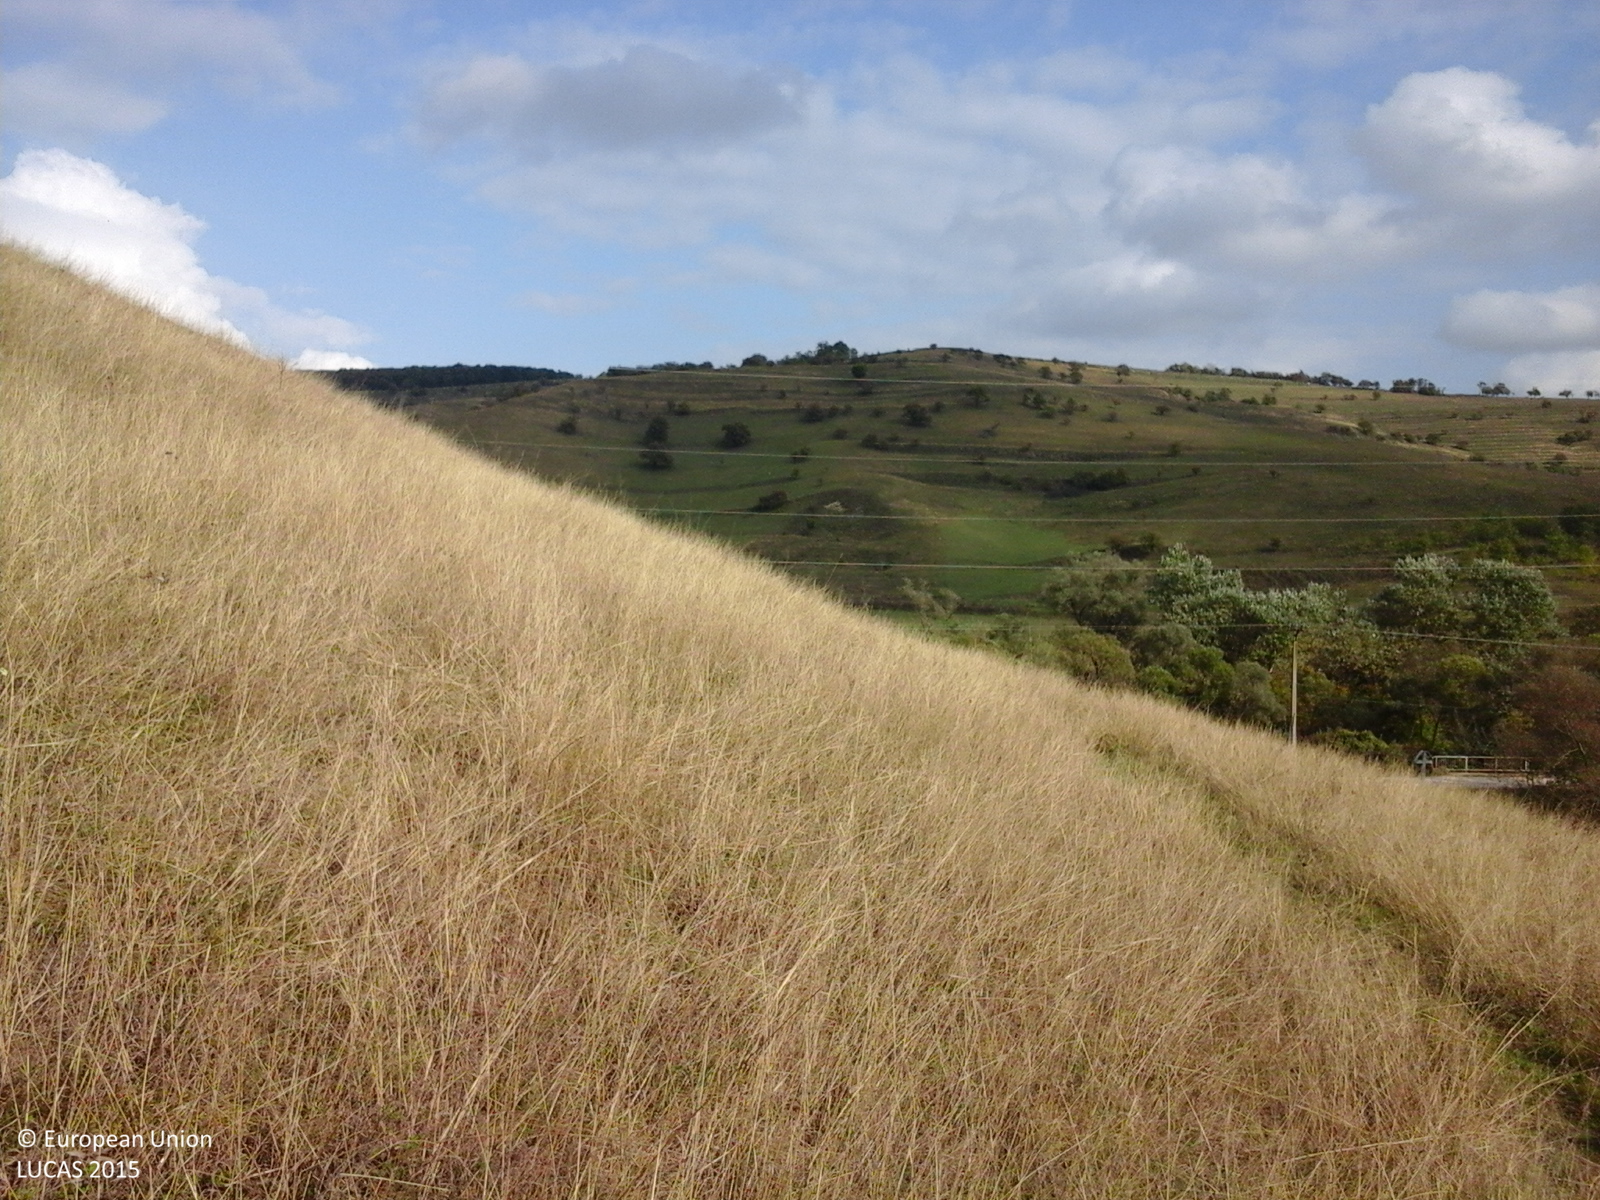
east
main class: Grassland
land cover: Grassland without tree/shrub cover
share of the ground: > 75 %
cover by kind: herbaceous plants 100 %
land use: Agriculture (excluding fallow land and kitchen gardens)
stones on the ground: < 10 %
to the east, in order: Grassland without tree/shrub cover; Electric lines; Grass margins; Tracks; Grassland without tree/shrub cover; Electric lines; Grassland without tree/shrub cover; Electric lines; Broadleaved woodland; Rivers and streams; Broadleaved woodland; Shruby margins; Spontaneously vegetated surfaces
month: October
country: RO
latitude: 46.1890
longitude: 24.1617
